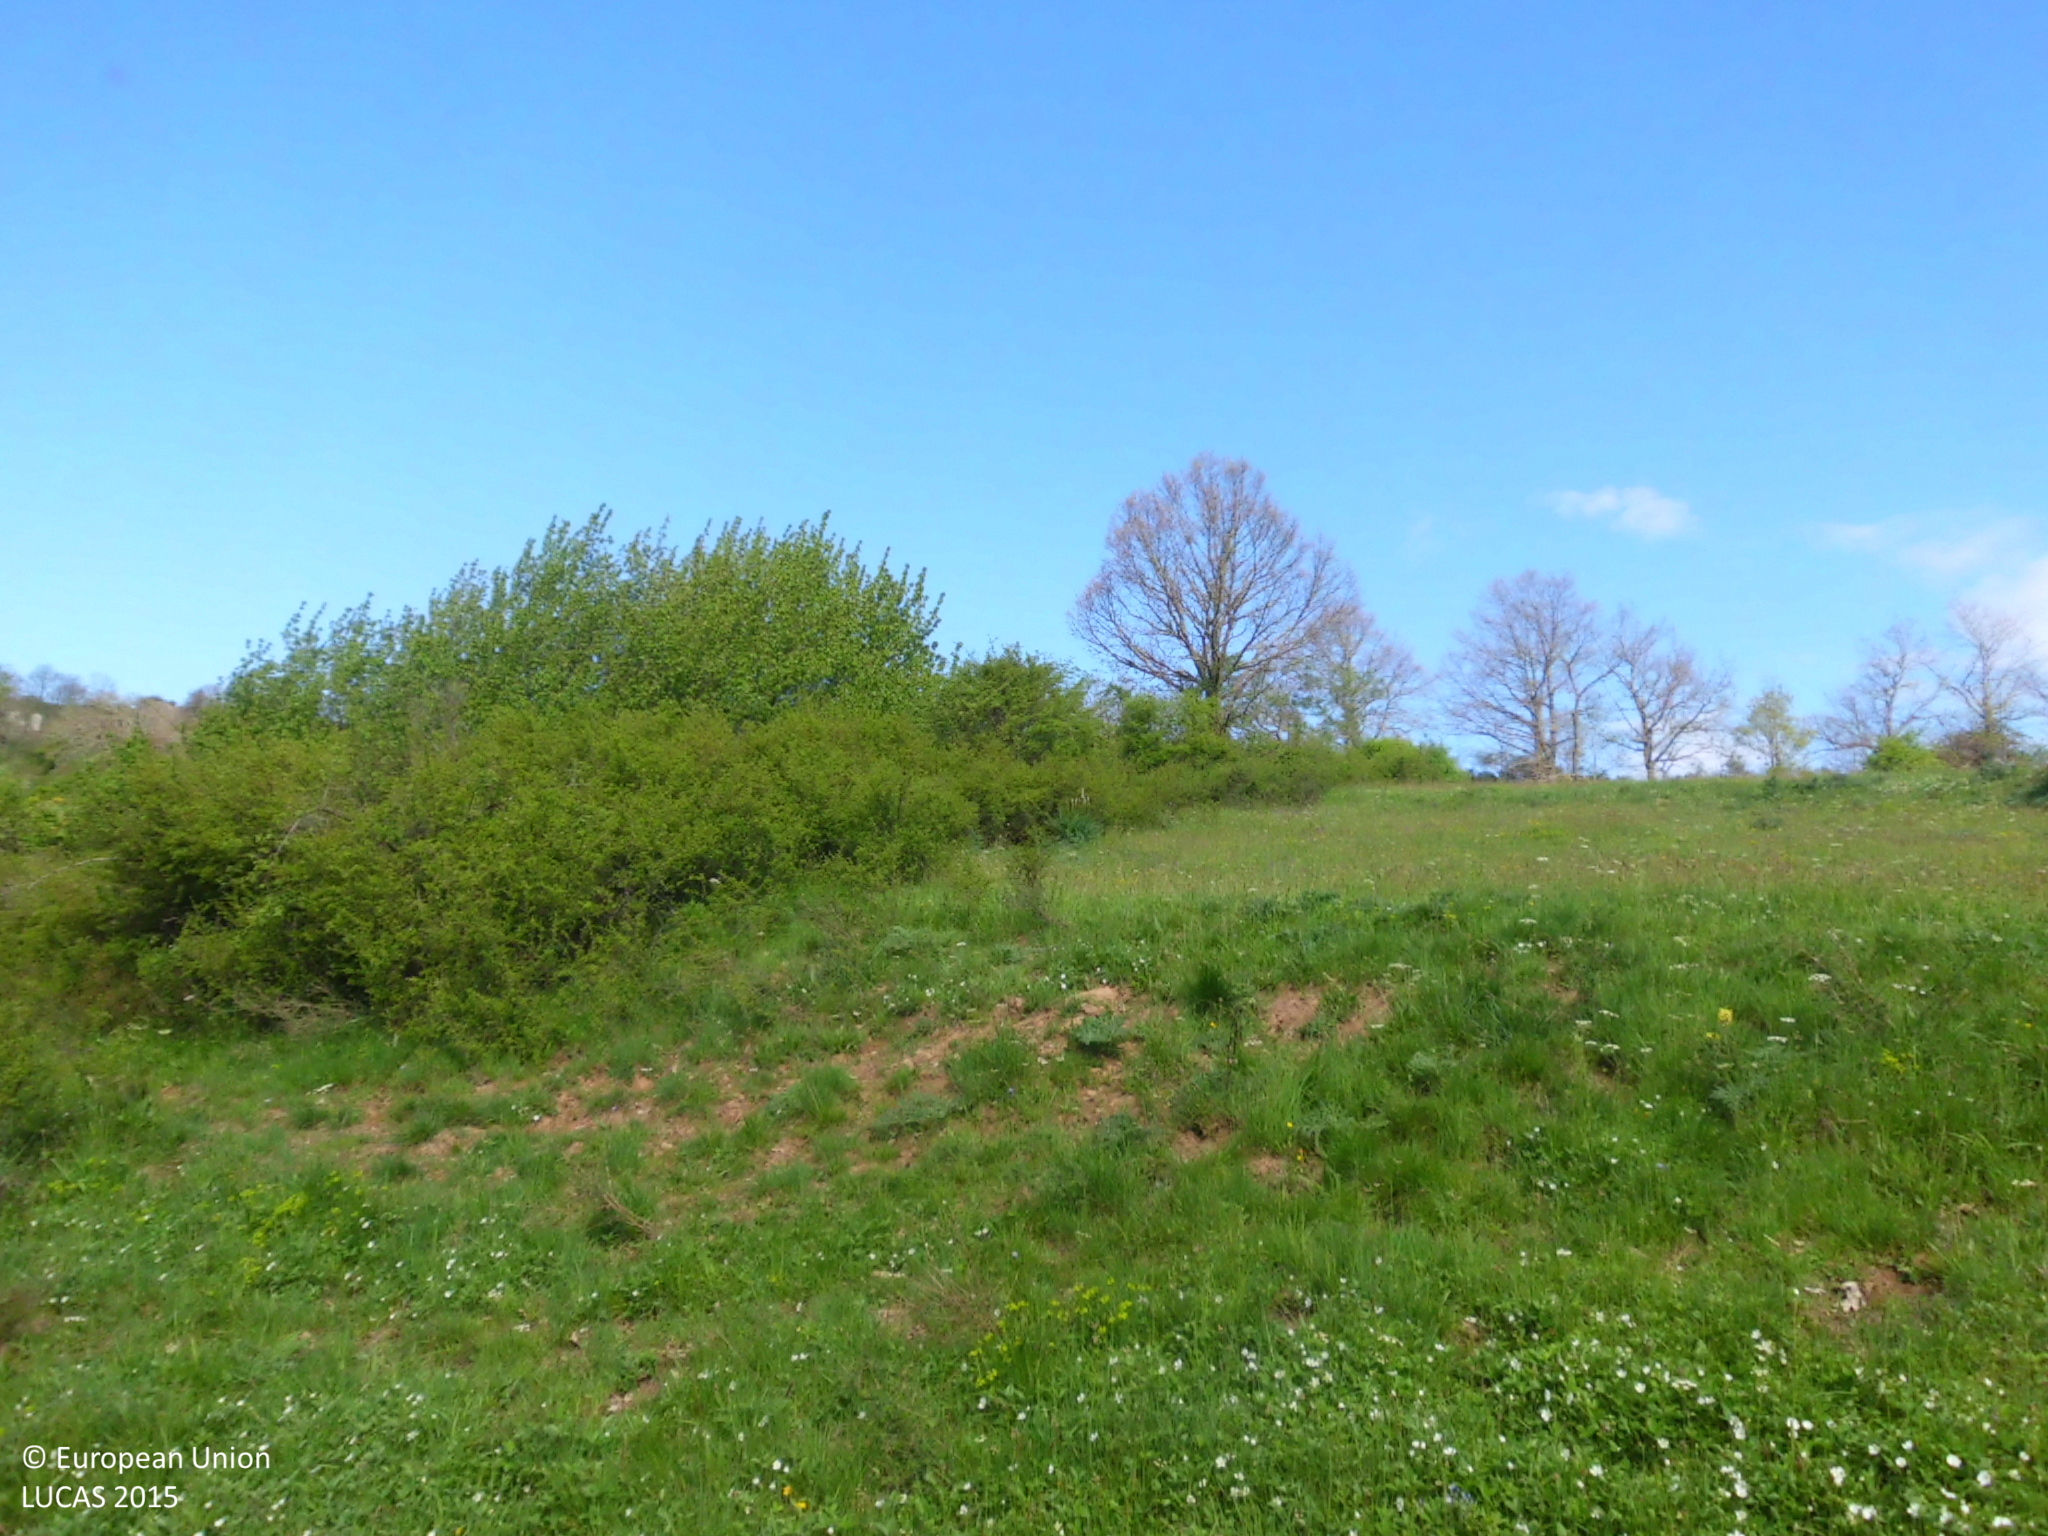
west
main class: Grassland
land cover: Grassland with sparse tree/shrub cover
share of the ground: 25 - 50 %
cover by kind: herbaceous plants 90 %, broadleaved forest trees 5 %, shrubs 5 %
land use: Abandoned areas
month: May
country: ES
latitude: 42.8950
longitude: -3.9201
